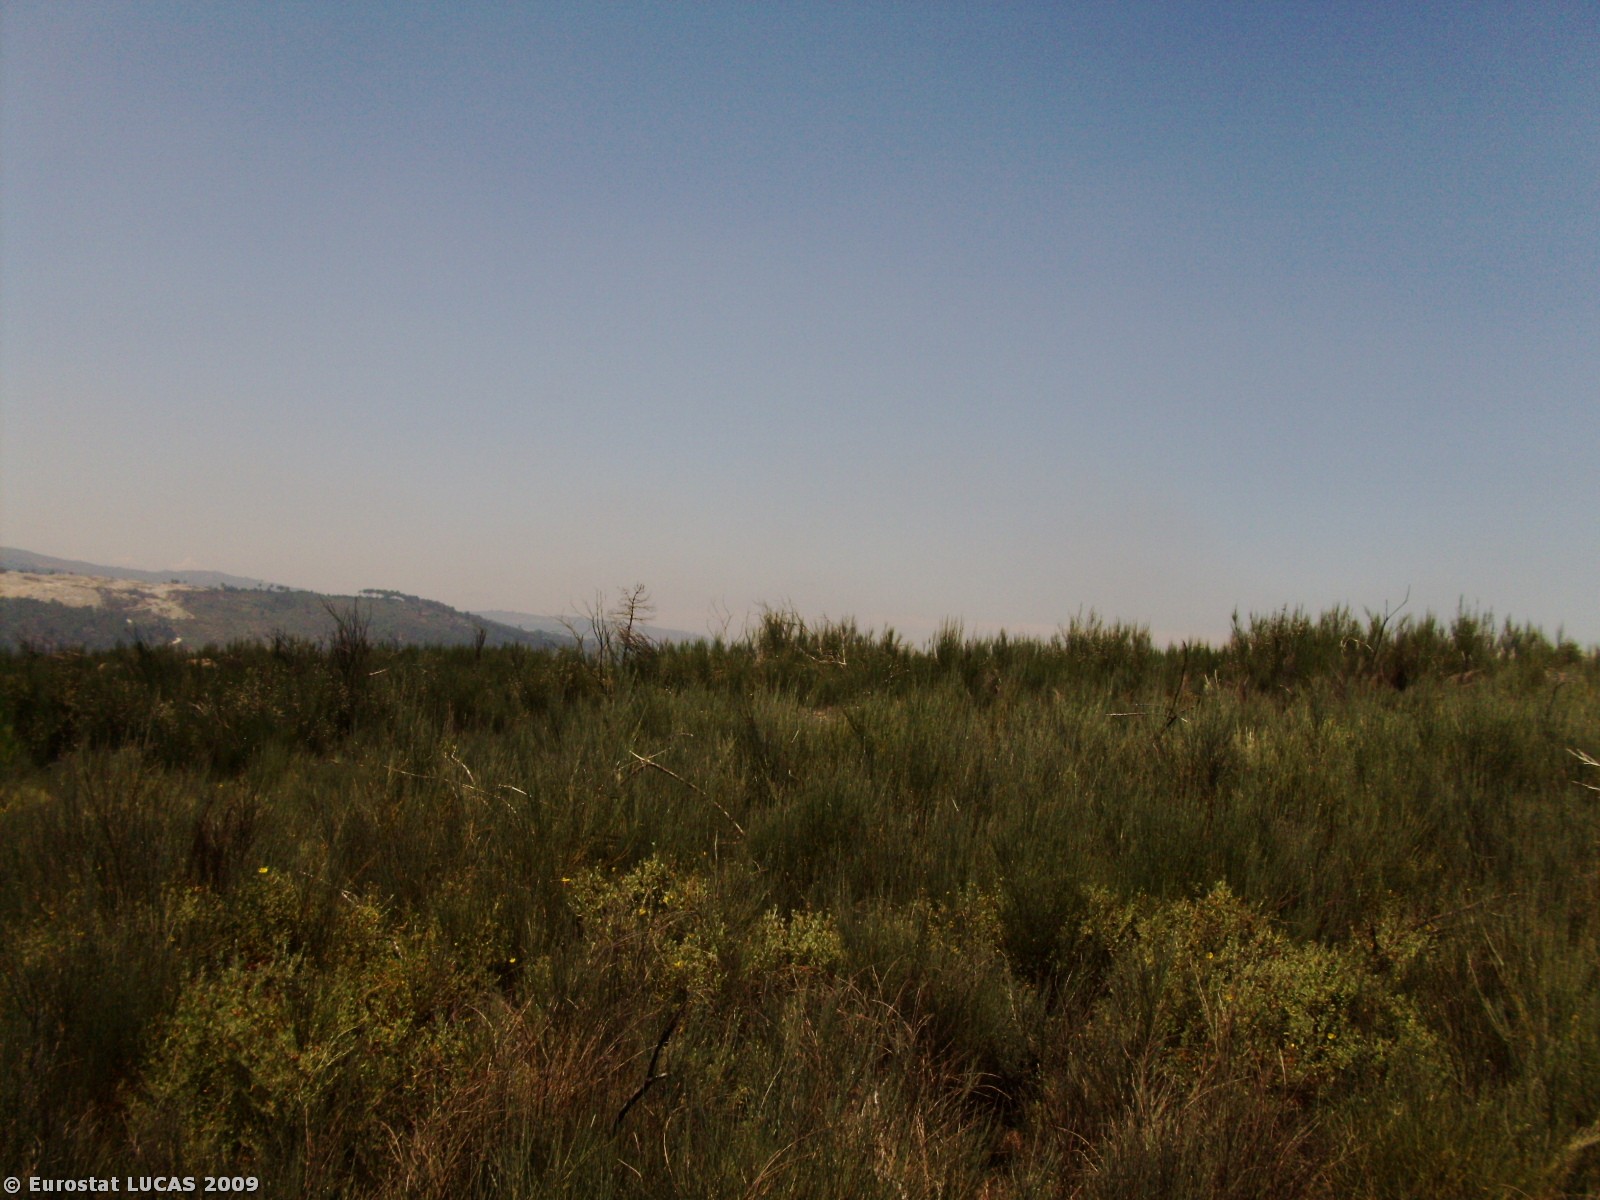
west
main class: Shrubland
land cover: Shrubland without tree cover
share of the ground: > 75 %
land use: Unused
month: July
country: PT
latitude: 40.6501
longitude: -7.6314
